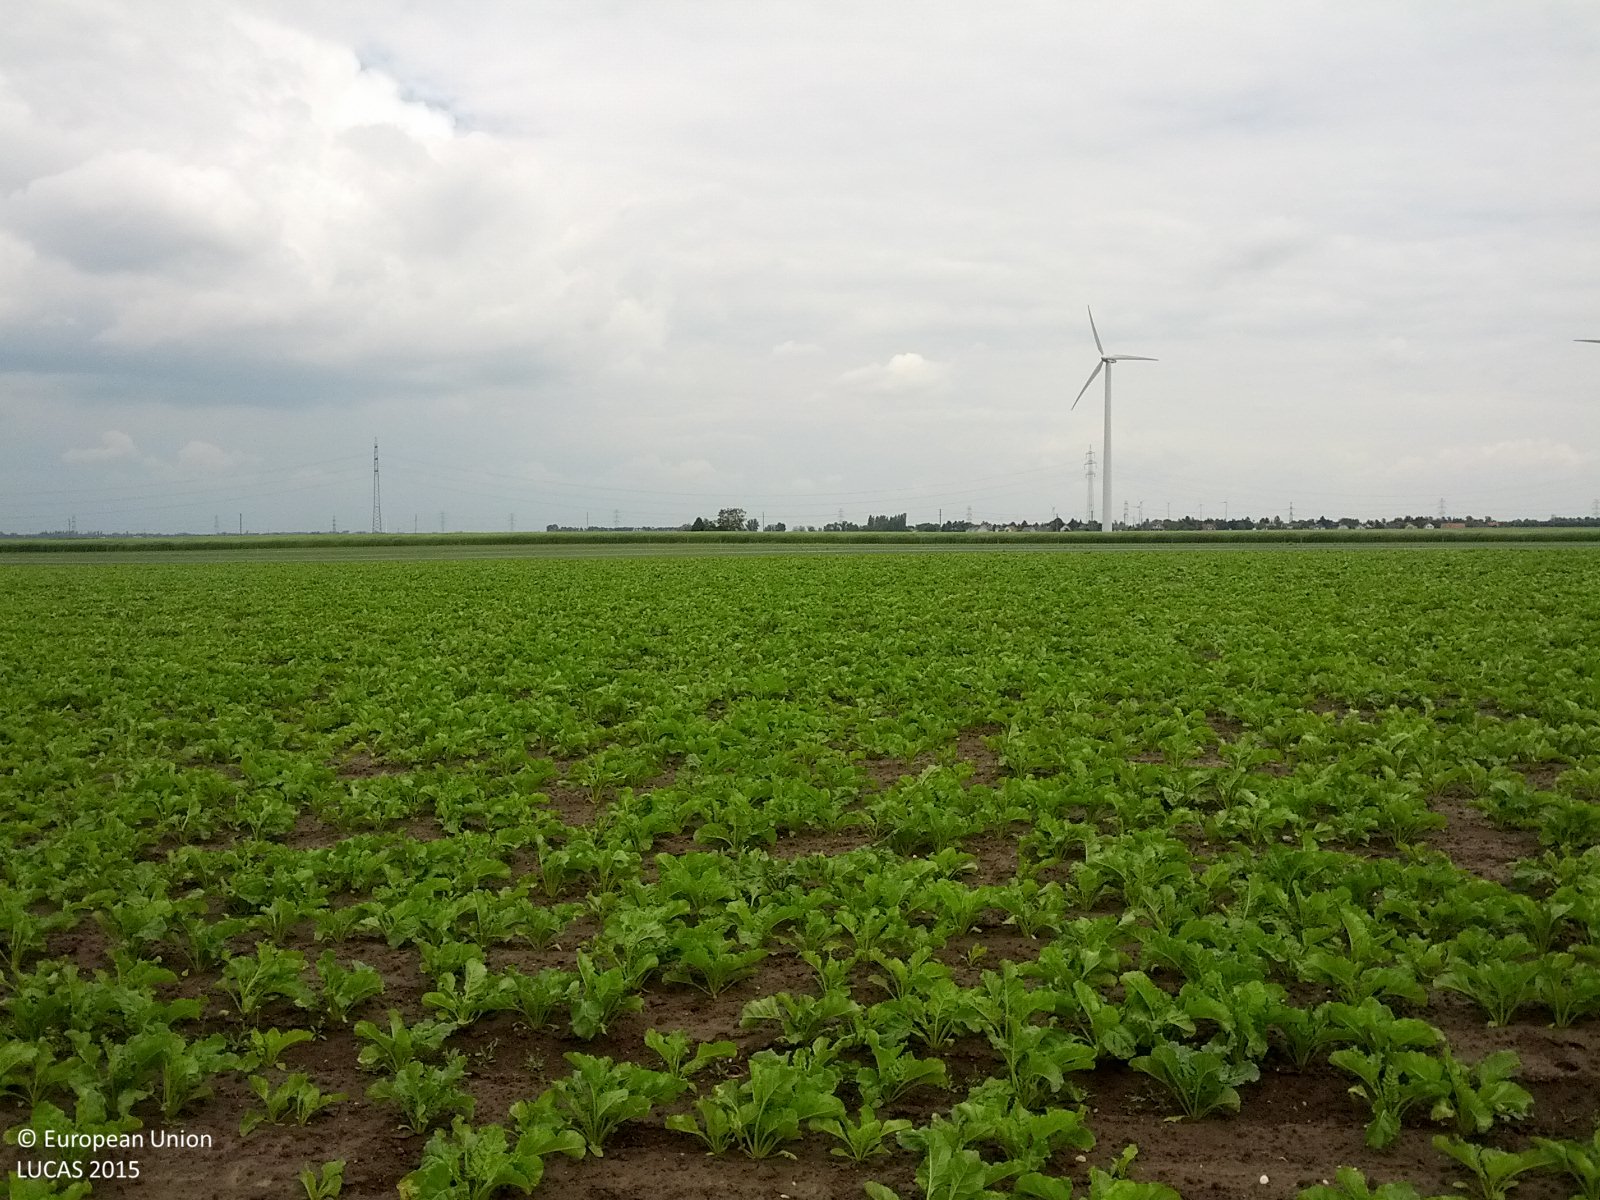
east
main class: Cropland
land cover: Sugar beet
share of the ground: 50 - 75 %
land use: Agriculture (excluding fallow land and kitchen gardens)
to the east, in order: Sugar beet; Other fresh vegetables; Durum wheat; Other bare soil
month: May
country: AT
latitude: 48.2656
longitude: 16.5125
